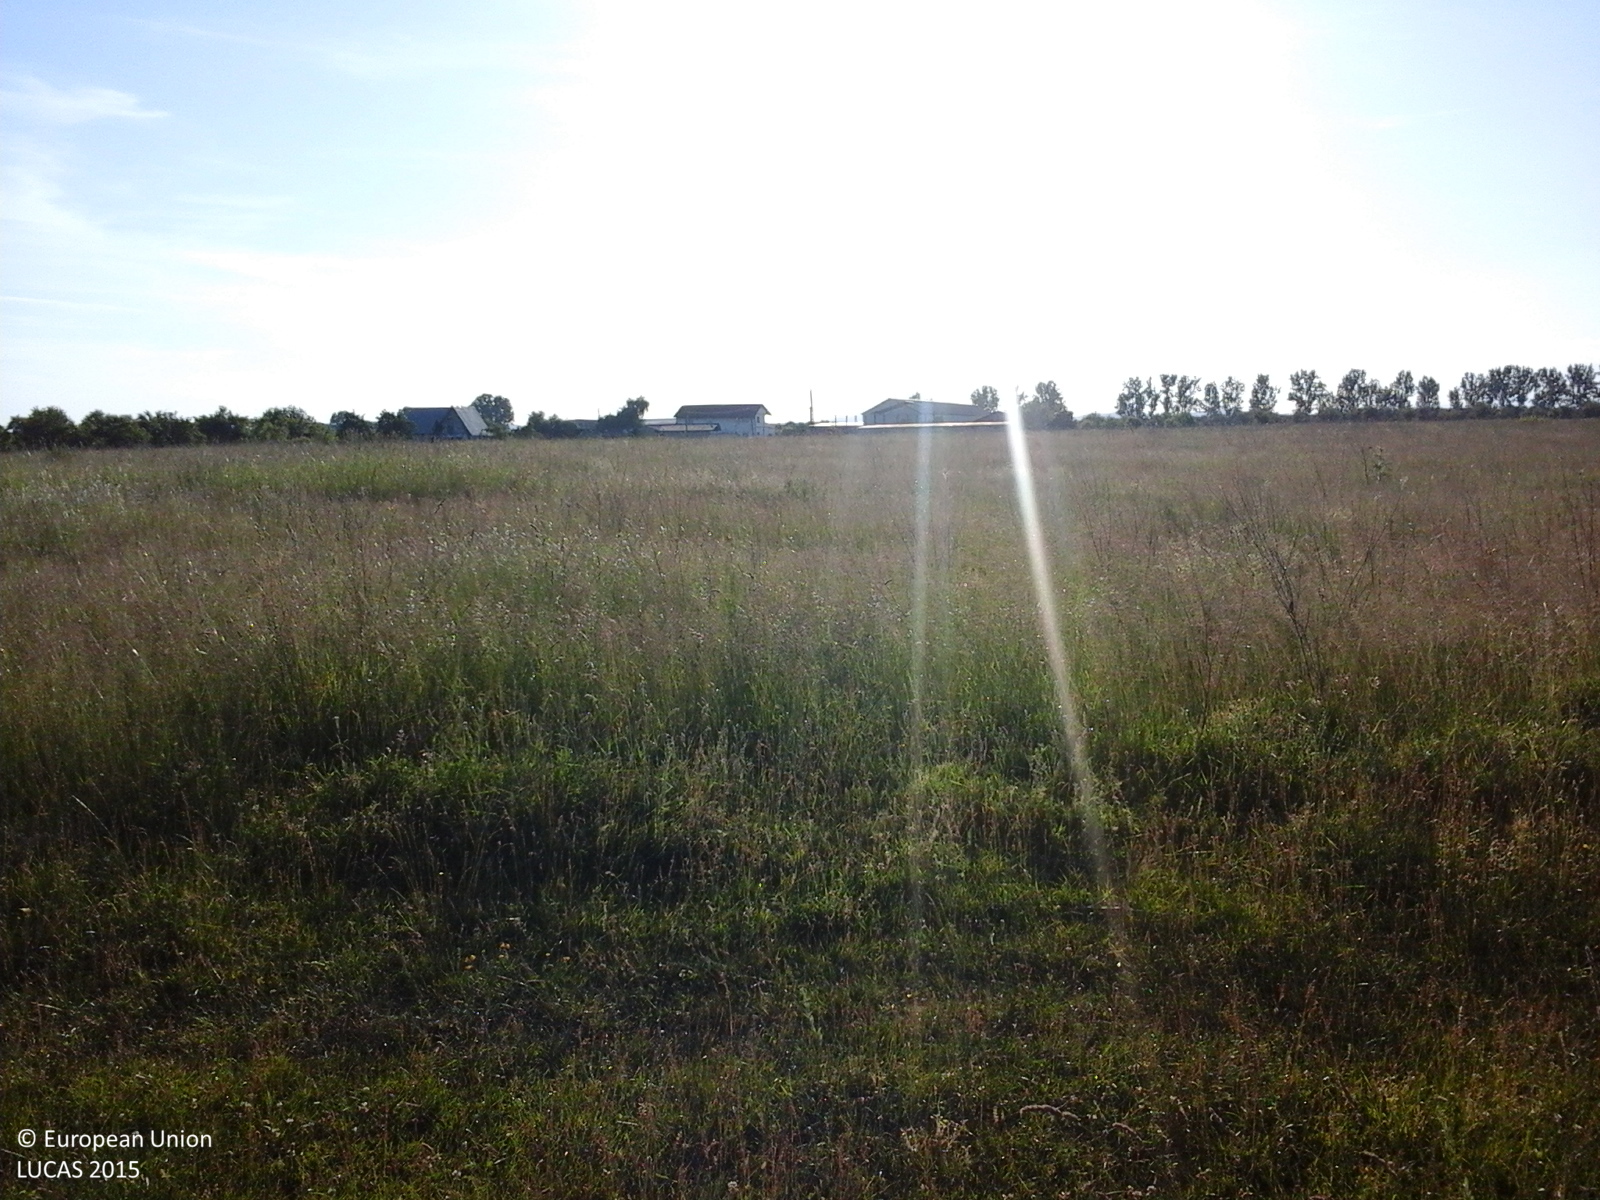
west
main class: Grassland
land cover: Grassland with sparse tree/shrub cover
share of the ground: > 75 %
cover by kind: herbaceous plants 85 %, shrubs 10 %, broadleaved forest trees 5 %
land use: Agriculture (excluding fallow land and kitchen gardens)
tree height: < 5 m
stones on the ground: < 10 %
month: June
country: RO
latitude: 45.0480
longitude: 25.8617
